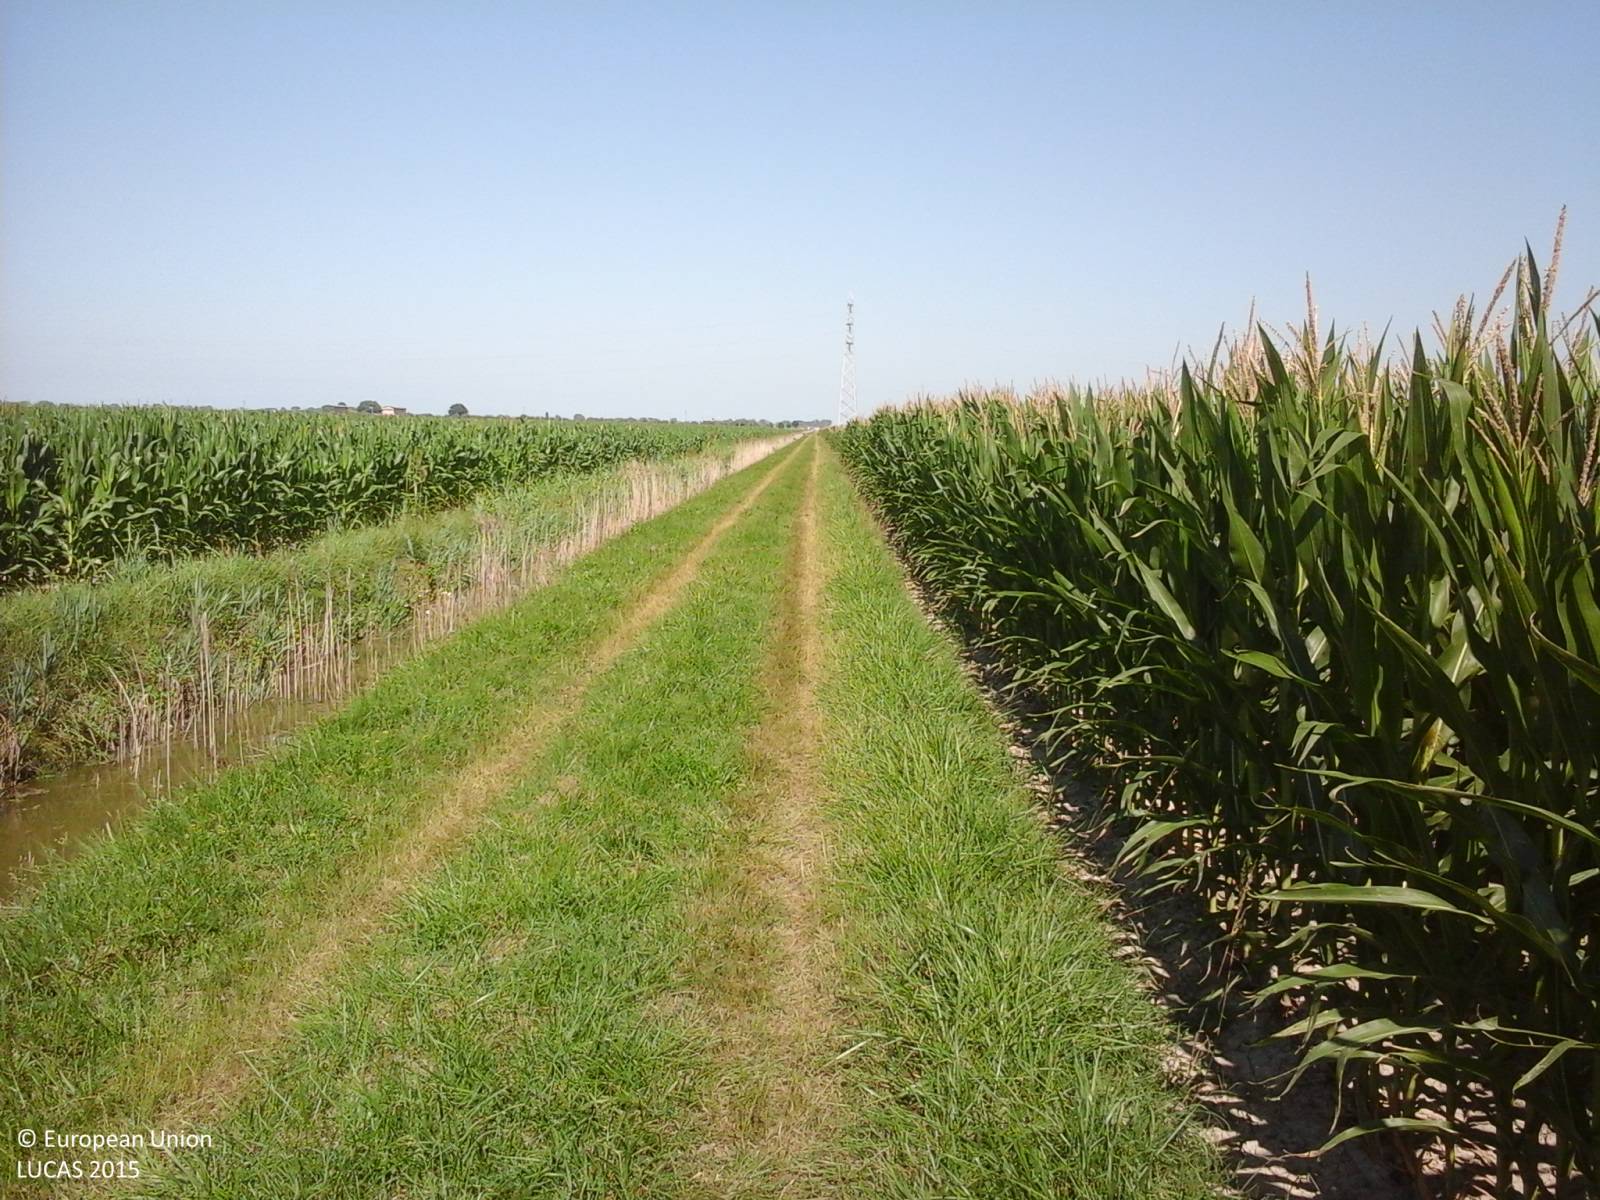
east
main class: Cropland
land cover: Maize
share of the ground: > 75 %
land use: Agriculture (excluding fallow land and kitchen gardens)
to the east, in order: Maize
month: July
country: IT
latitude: 45.6598
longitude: 13.0120
